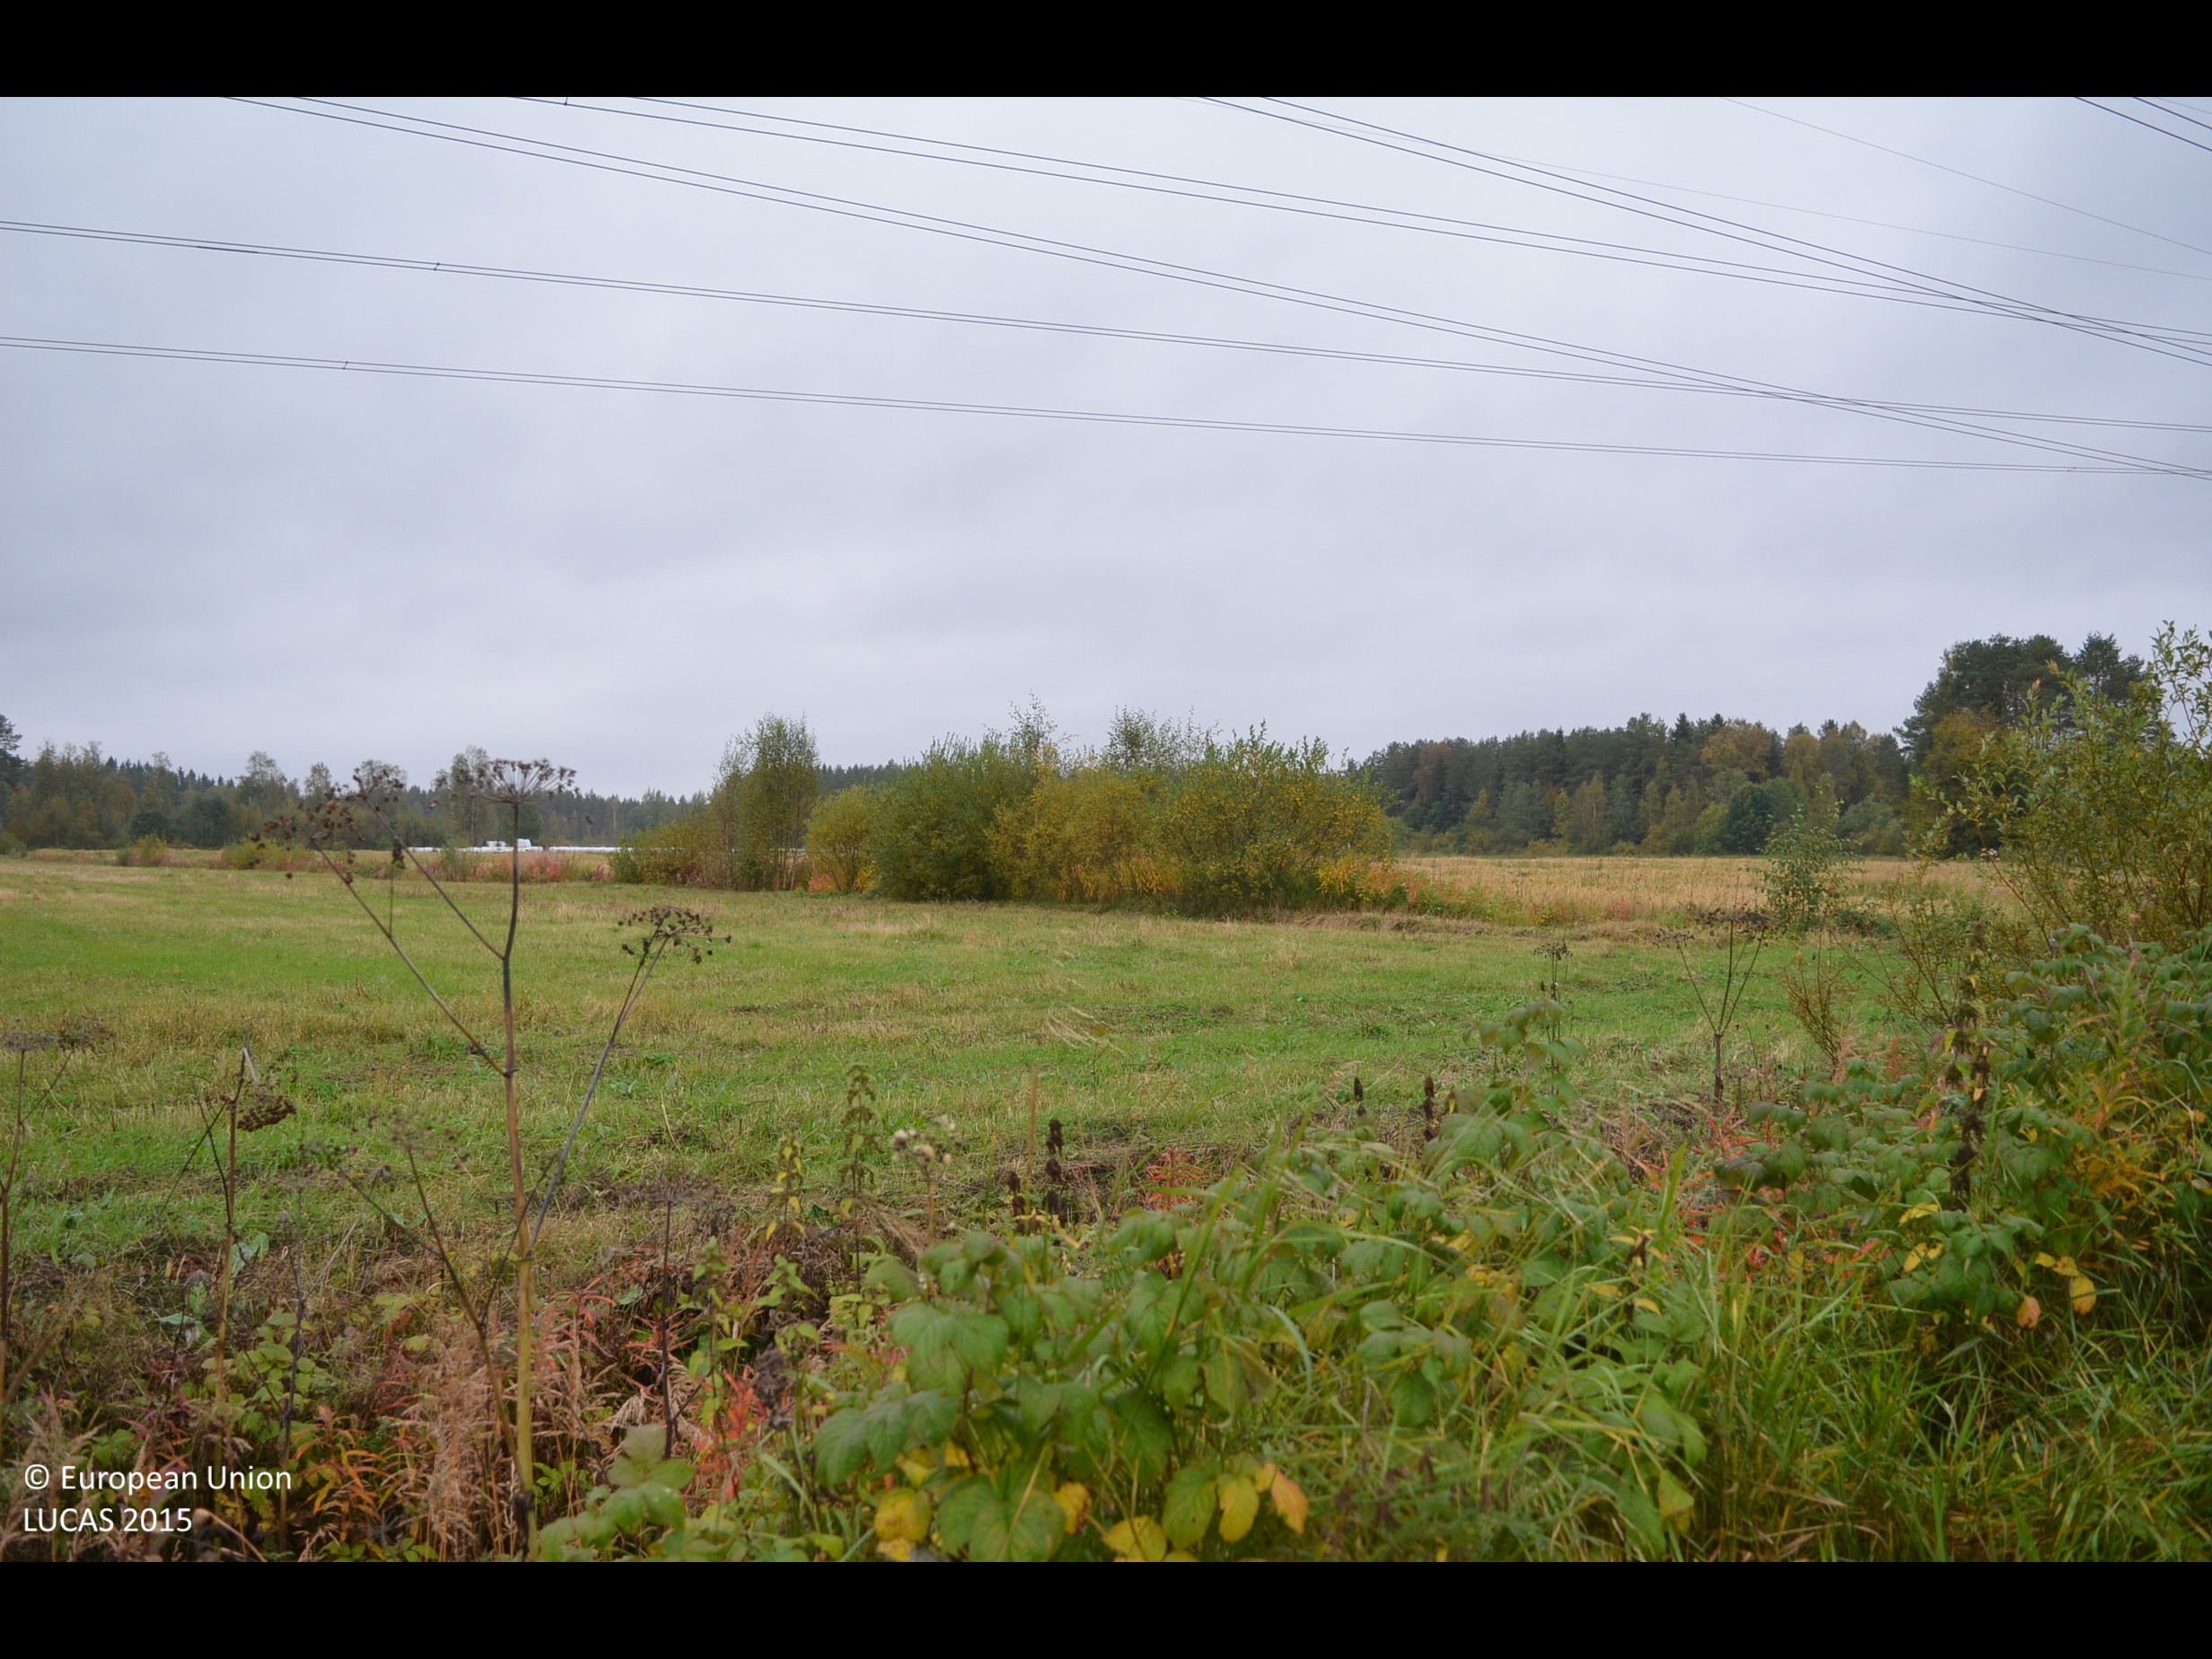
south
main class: Cropland
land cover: Temporary grasslands
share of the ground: > 75 %
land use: Agriculture (excluding fallow land and kitchen gardens)
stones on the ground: < 10 %
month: September
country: FI
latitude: 62.9347
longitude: 23.7229
